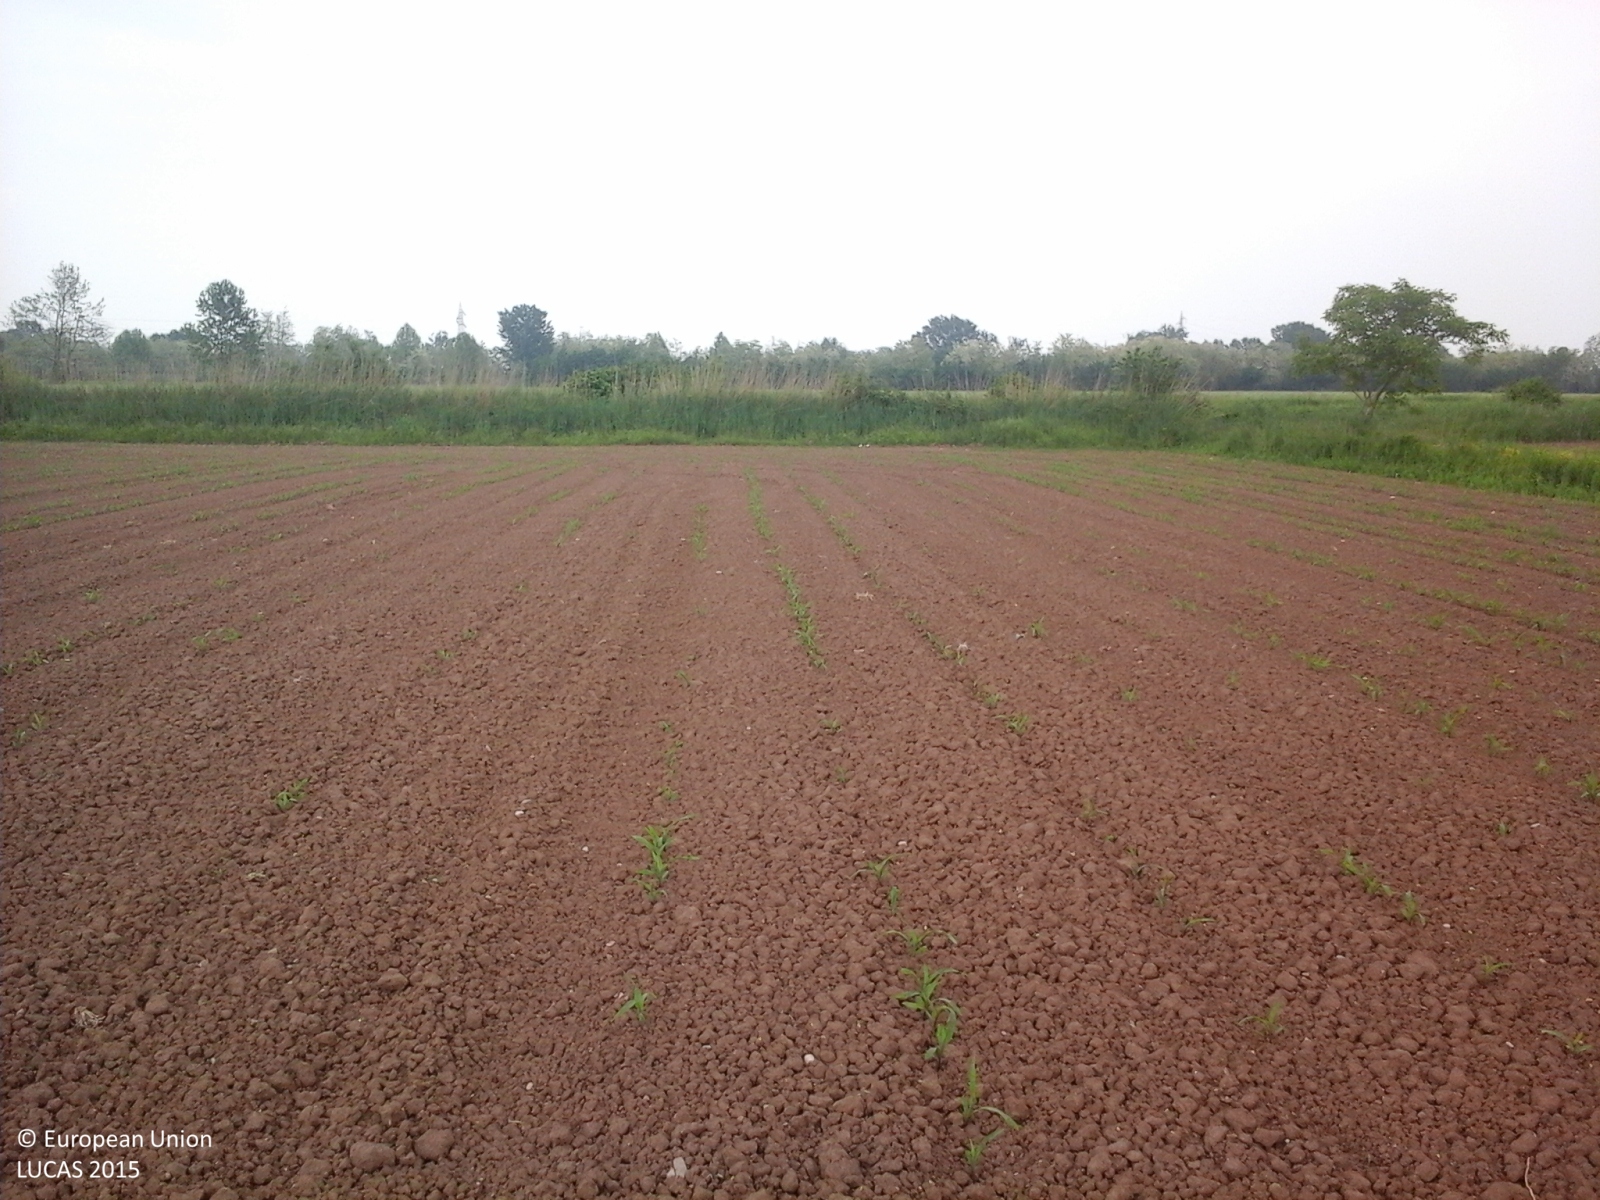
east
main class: Cropland
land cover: Maize
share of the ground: < 10 %
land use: Agriculture (excluding fallow land and kitchen gardens)
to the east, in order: Maize; Grass margins; Ditches and canals; Abandoned hedges; Grass margins; Common wheat
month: May
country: IT
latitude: 45.2333
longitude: 10.3941
